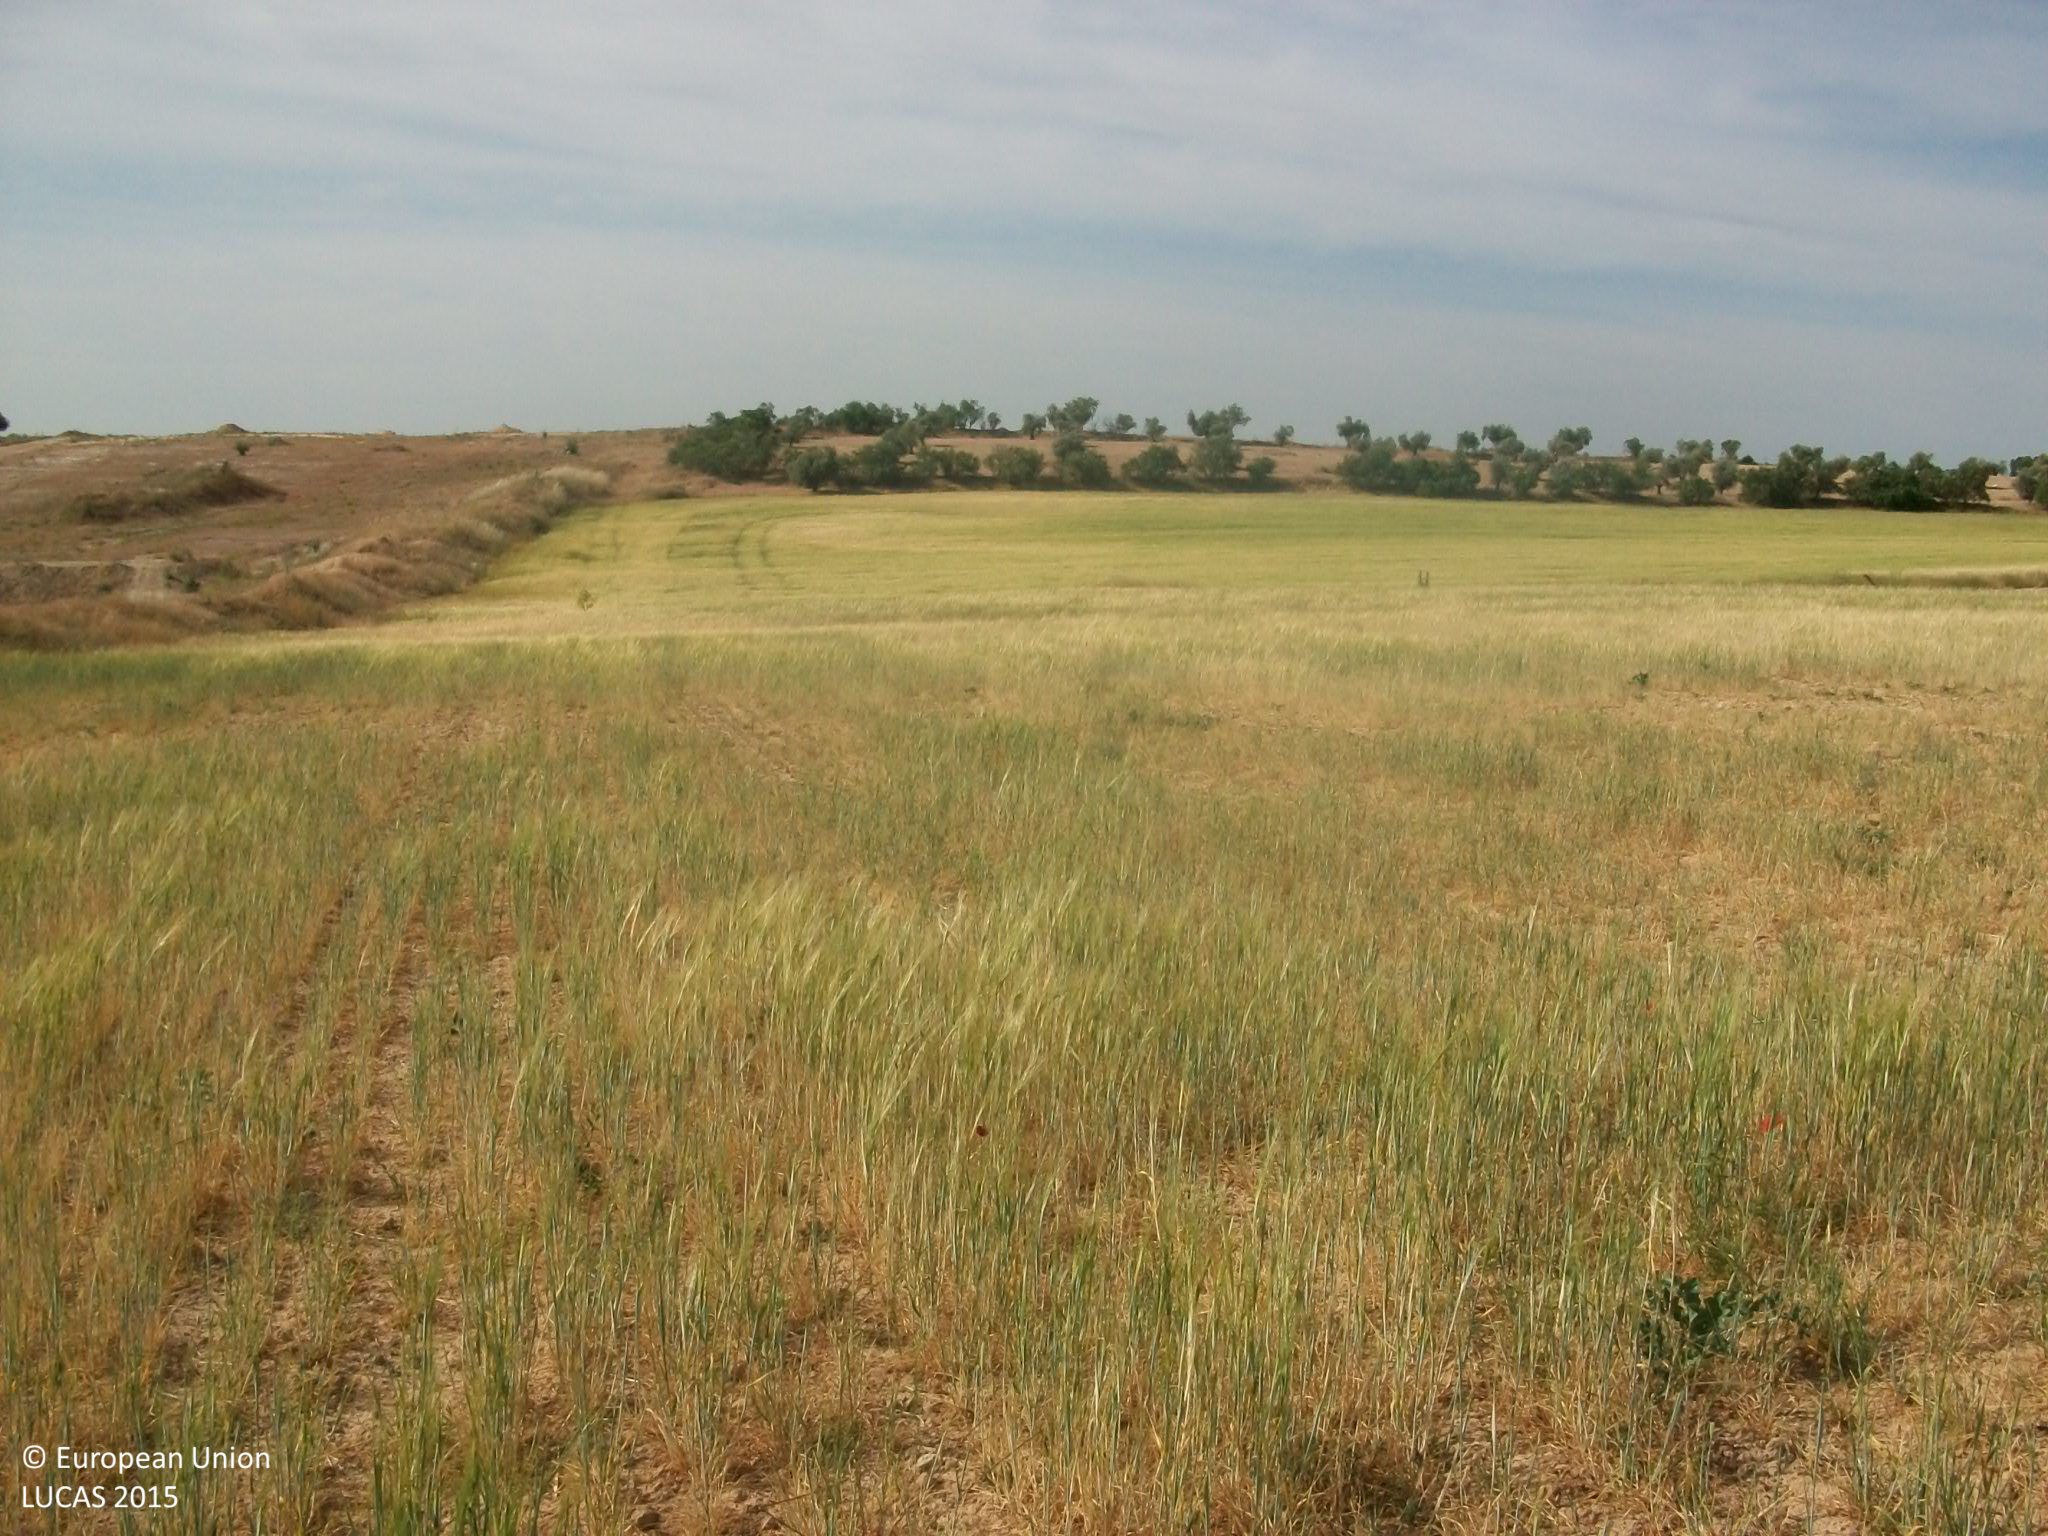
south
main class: Cropland
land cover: Barley
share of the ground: 50 - 75 %
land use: Agriculture (excluding fallow land and kitchen gardens)
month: May
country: ES
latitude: 40.0685
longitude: -3.7162
